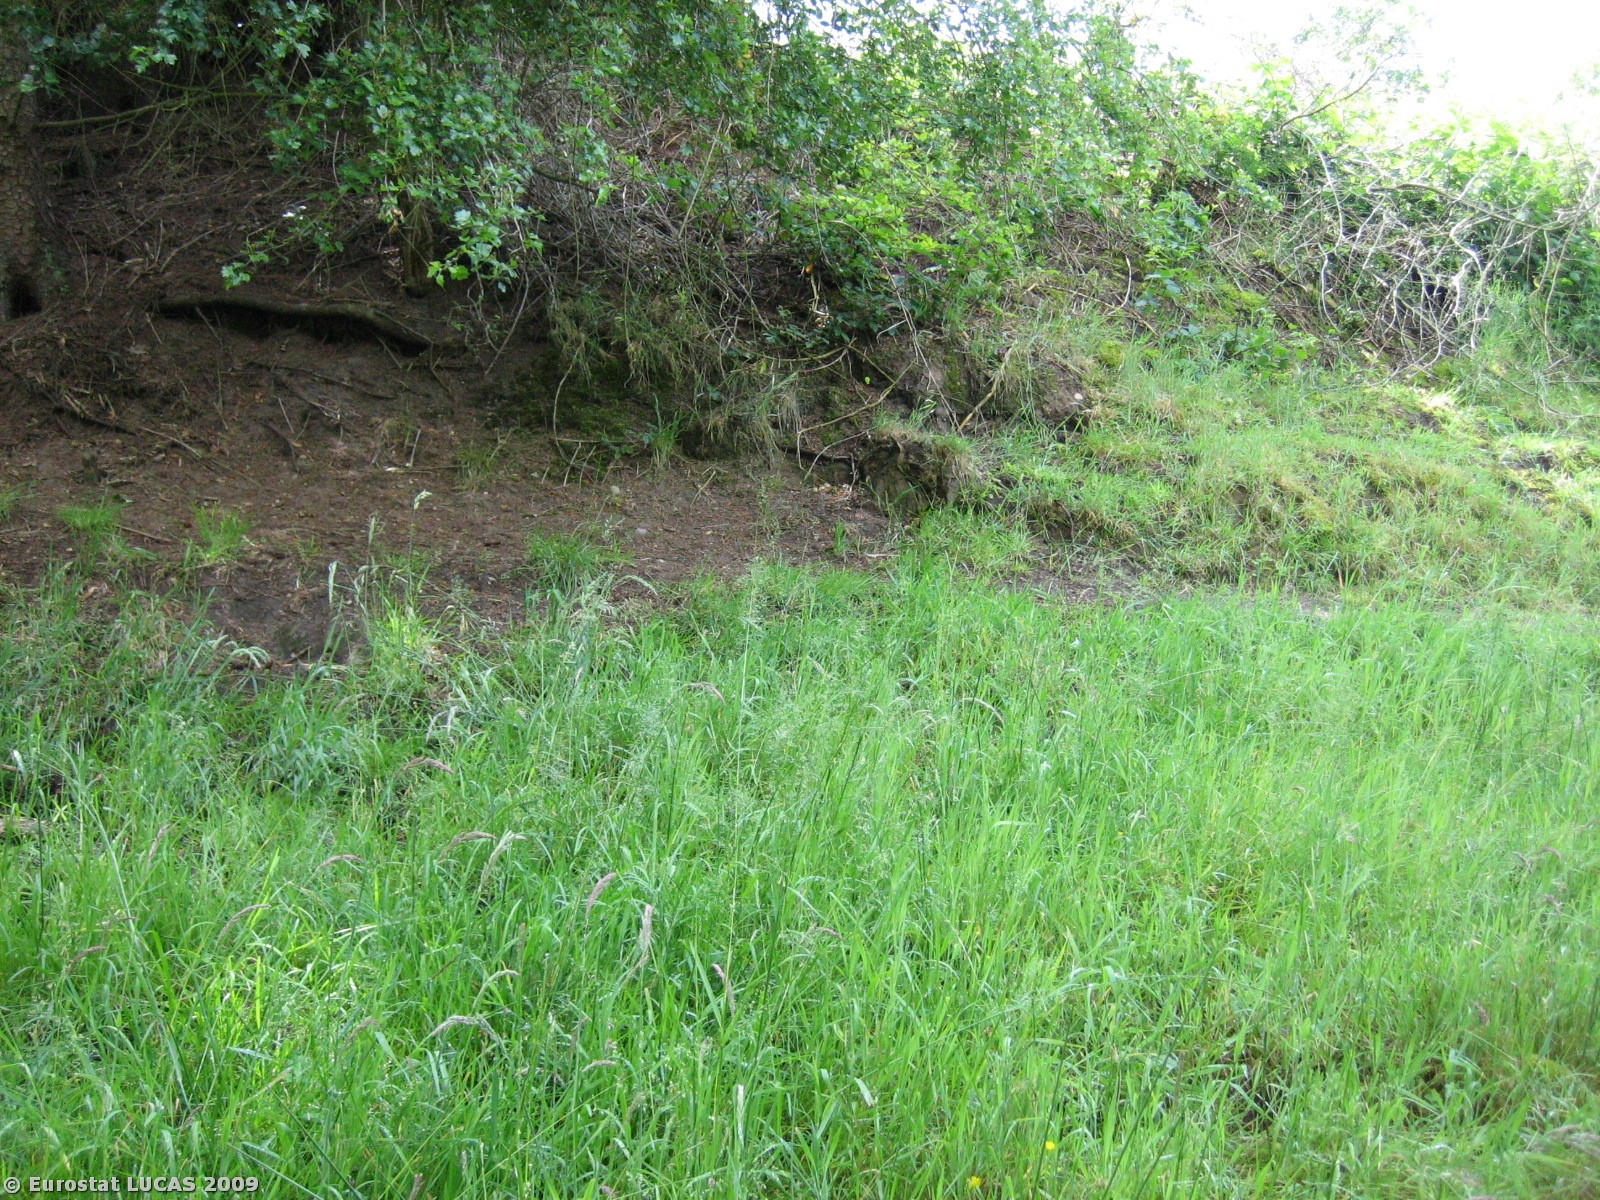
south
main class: Woodland
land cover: Broadleaved woodland
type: non-riverine alder, birch or aspen forest
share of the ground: > 75 %
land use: Agriculture (excluding fallow land and kitchen gardens)
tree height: > 5 m
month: June
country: DK
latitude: 55.6123
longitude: 9.7304
